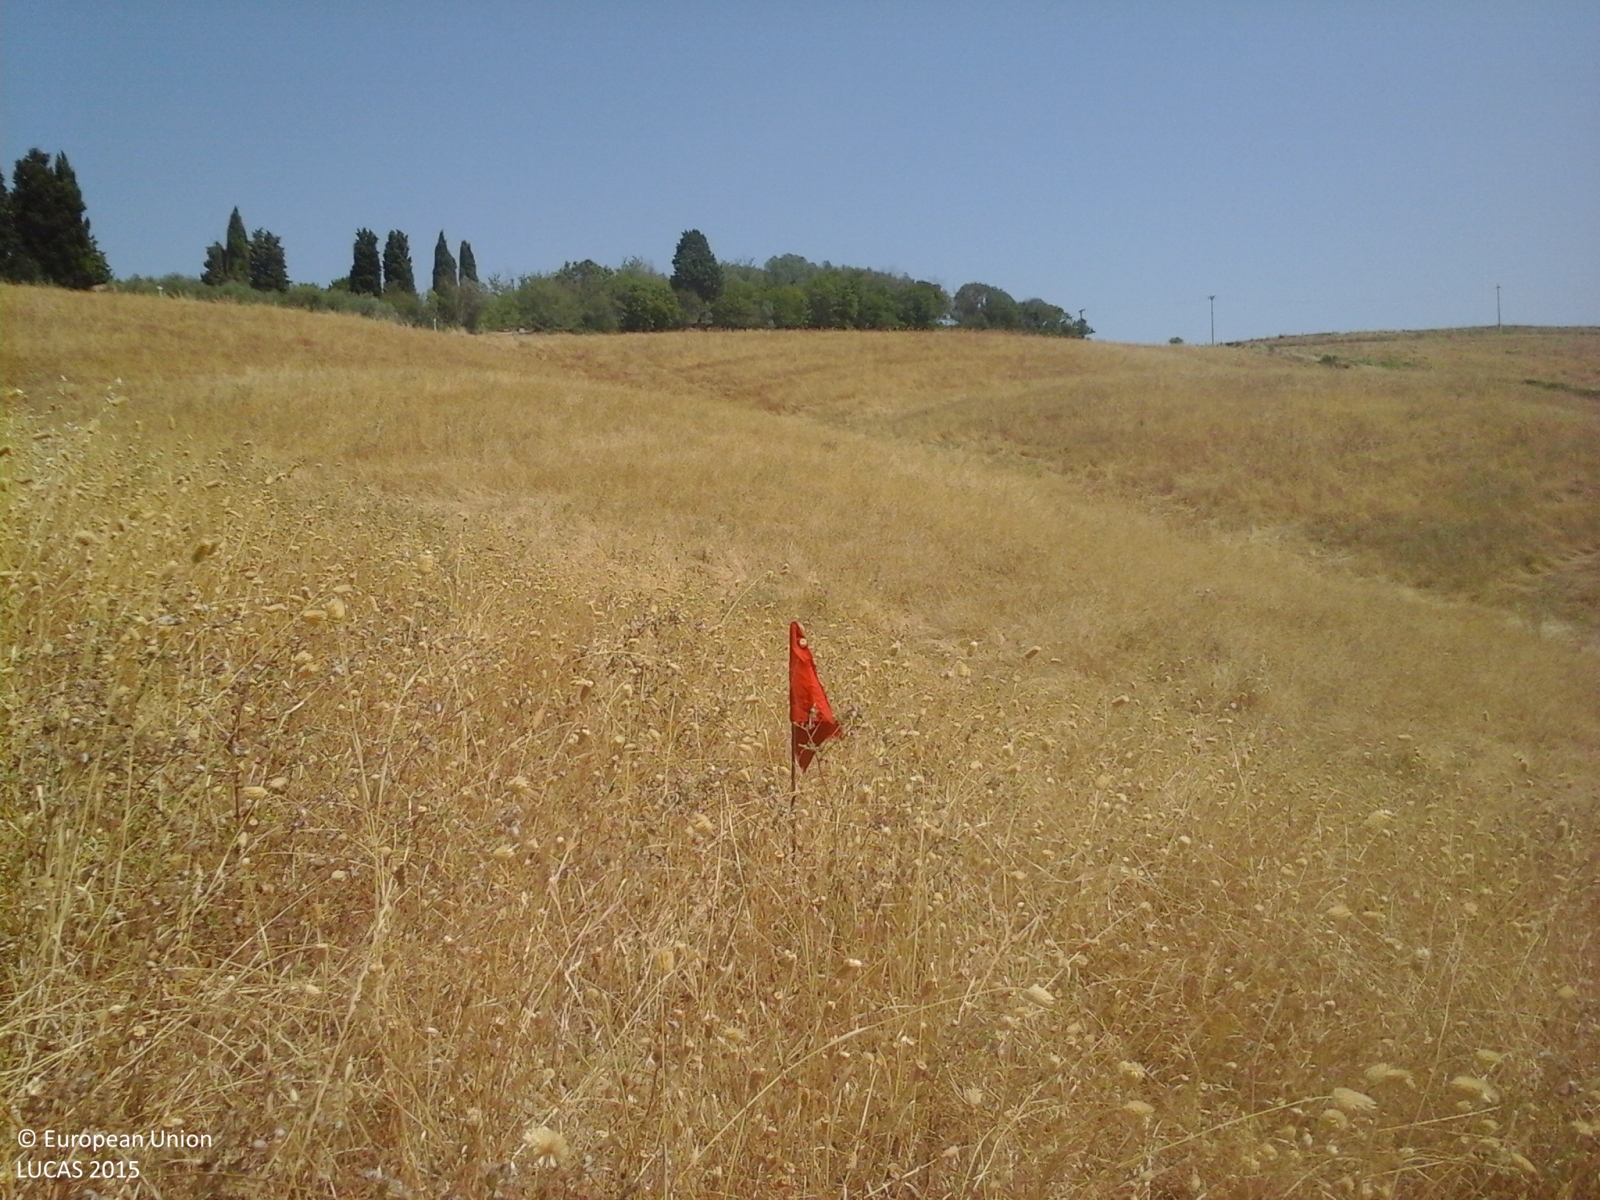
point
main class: Cropland
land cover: Temporary grasslands
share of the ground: > 75 %
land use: Agriculture (excluding fallow land and kitchen gardens)
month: July
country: IT
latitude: 43.1120
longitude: 11.5315
